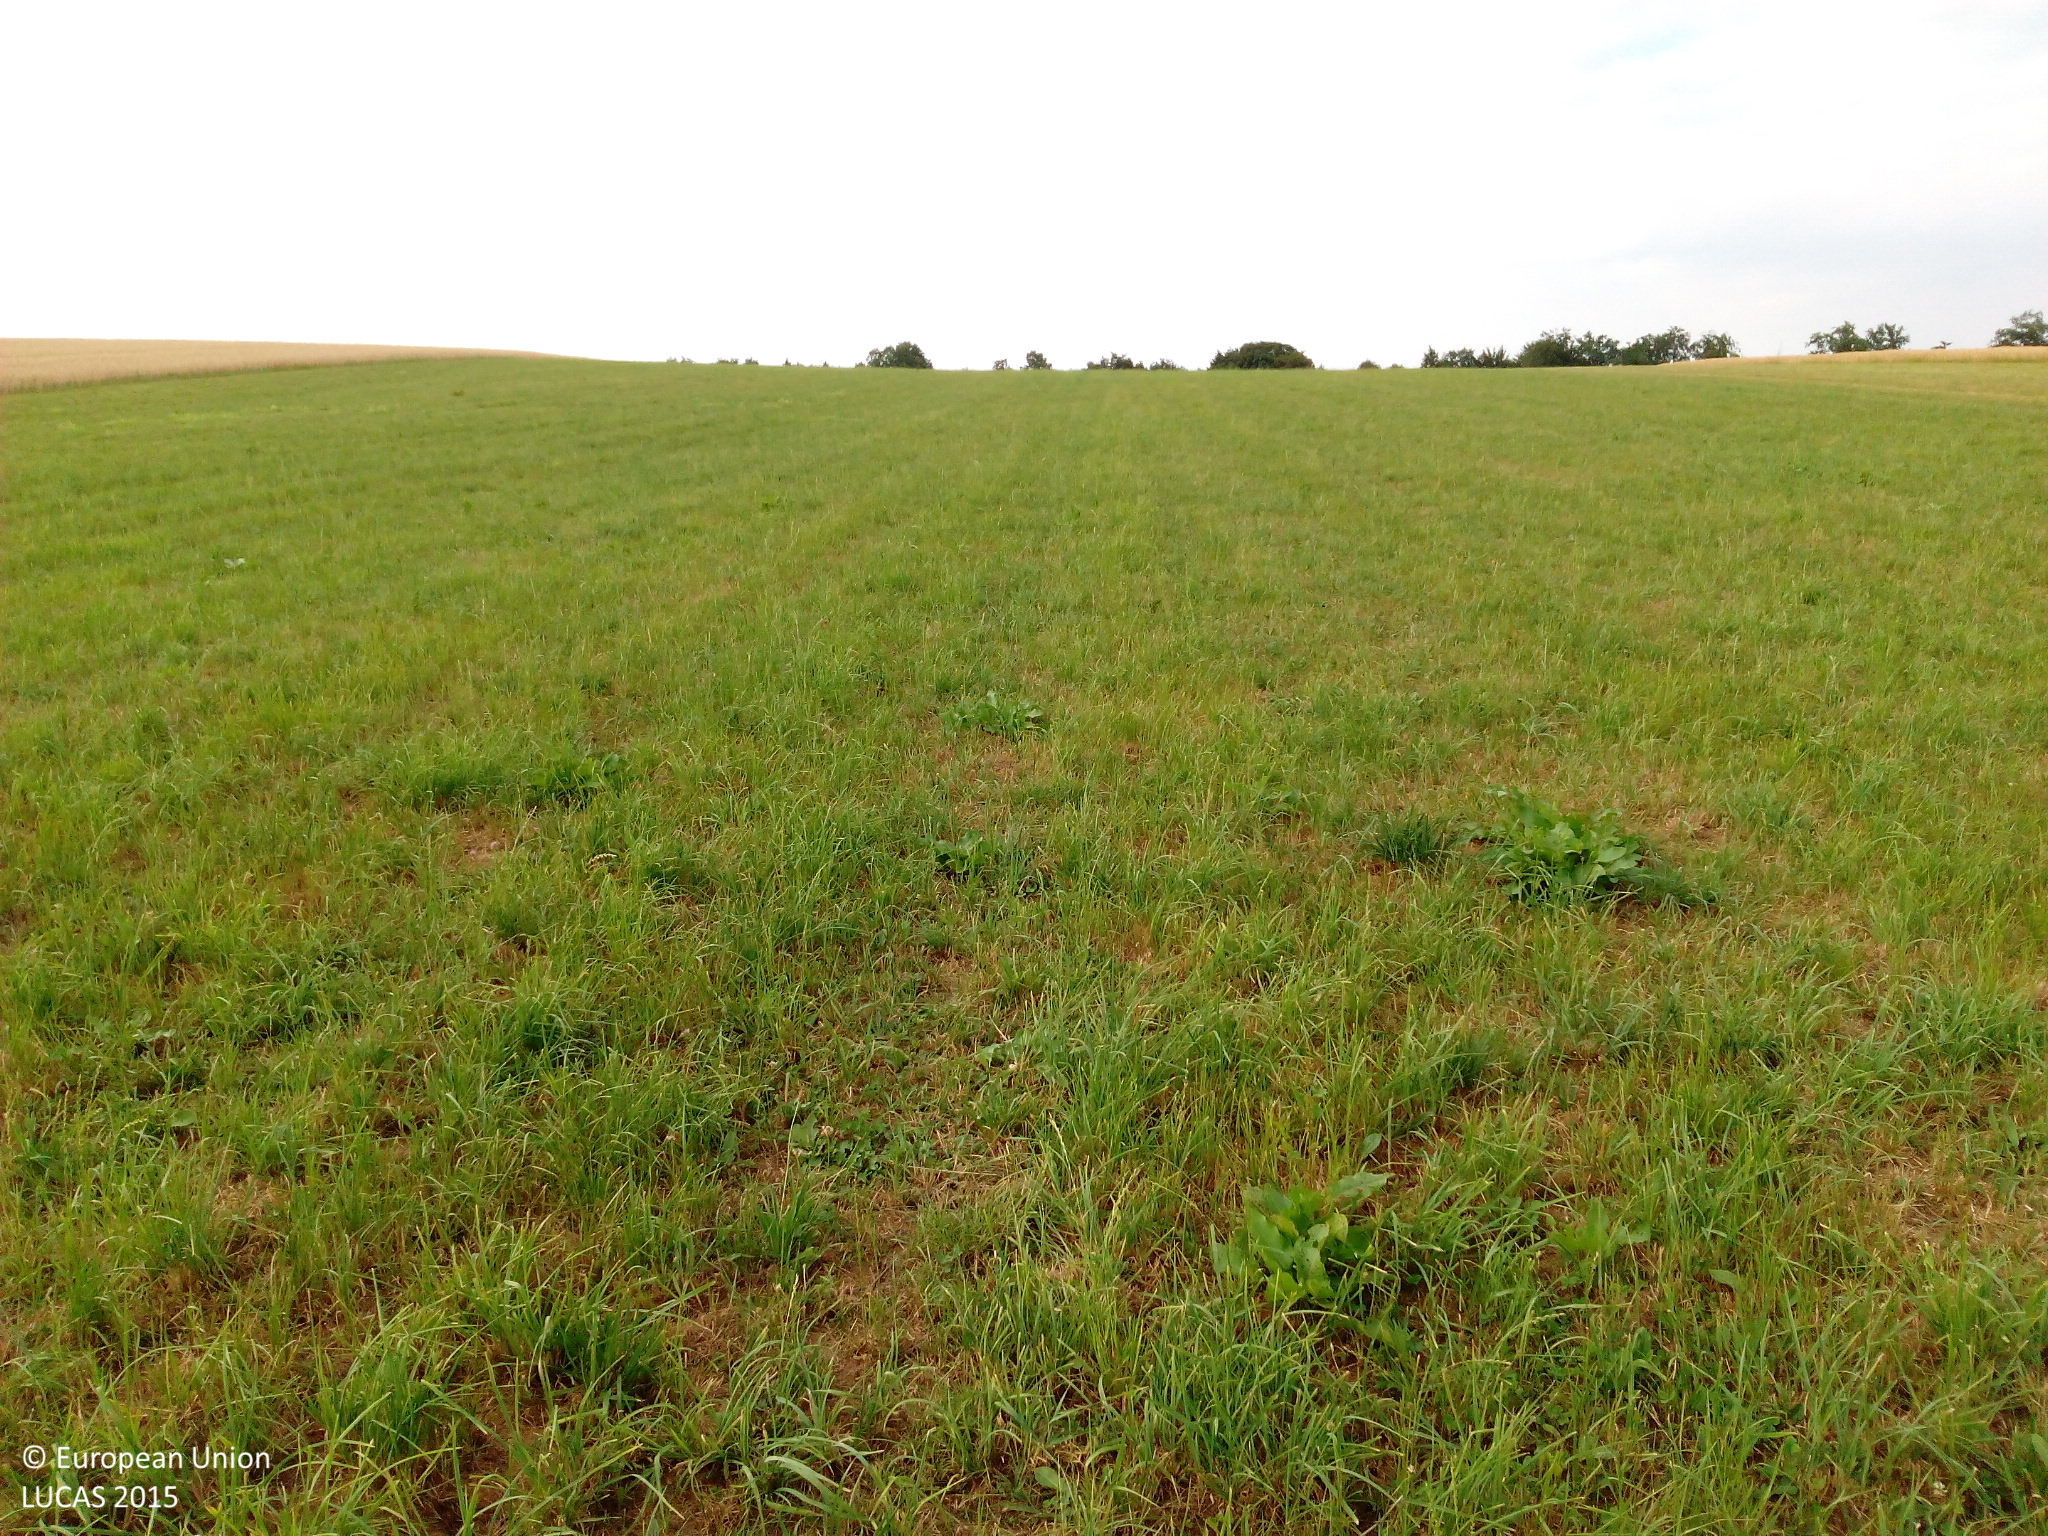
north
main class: Grassland
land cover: Grassland without tree/shrub cover
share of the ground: > 75 %
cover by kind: herbaceous plants 80 %, unconsolidated bare surface 20 %
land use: Agriculture (excluding fallow land and kitchen gardens)
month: July
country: DE
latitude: 48.8713
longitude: 9.9591
